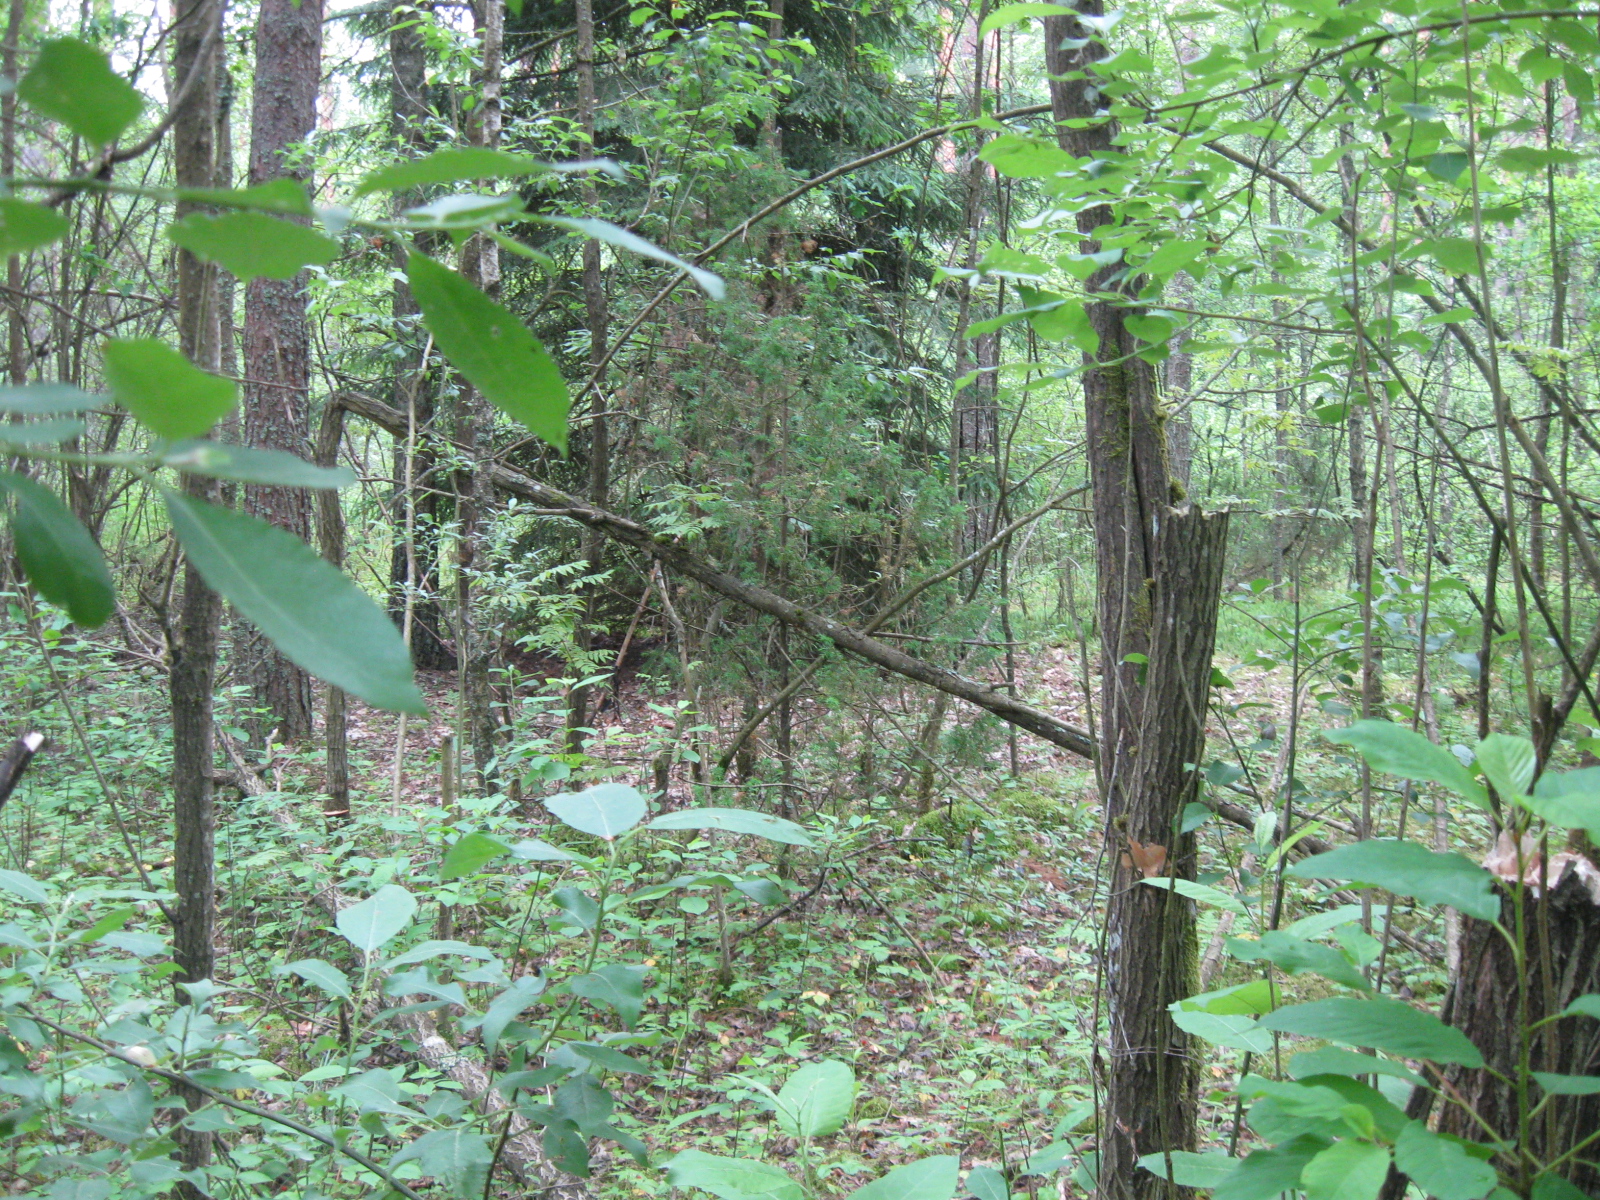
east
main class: Woodland
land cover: Other mixed woodland
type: hemiboreal forest and nemoral coniferous forest and mixed broadleaved-coniferous forest
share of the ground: > 75 %
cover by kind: broadleaved forest trees 55 %, coniferous forest trees 30 %, herbaceous plants 15 %
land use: Forestry
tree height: > 5 m
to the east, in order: Other mixed woodland; Tracks; Pine dominated mixed woodland; Other mixed woodland; Spruce dominated mixed woodland; Rivers and streams; Spruce dominated mixed woodland
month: June
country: LT
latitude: 54.4189
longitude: 24.7020
